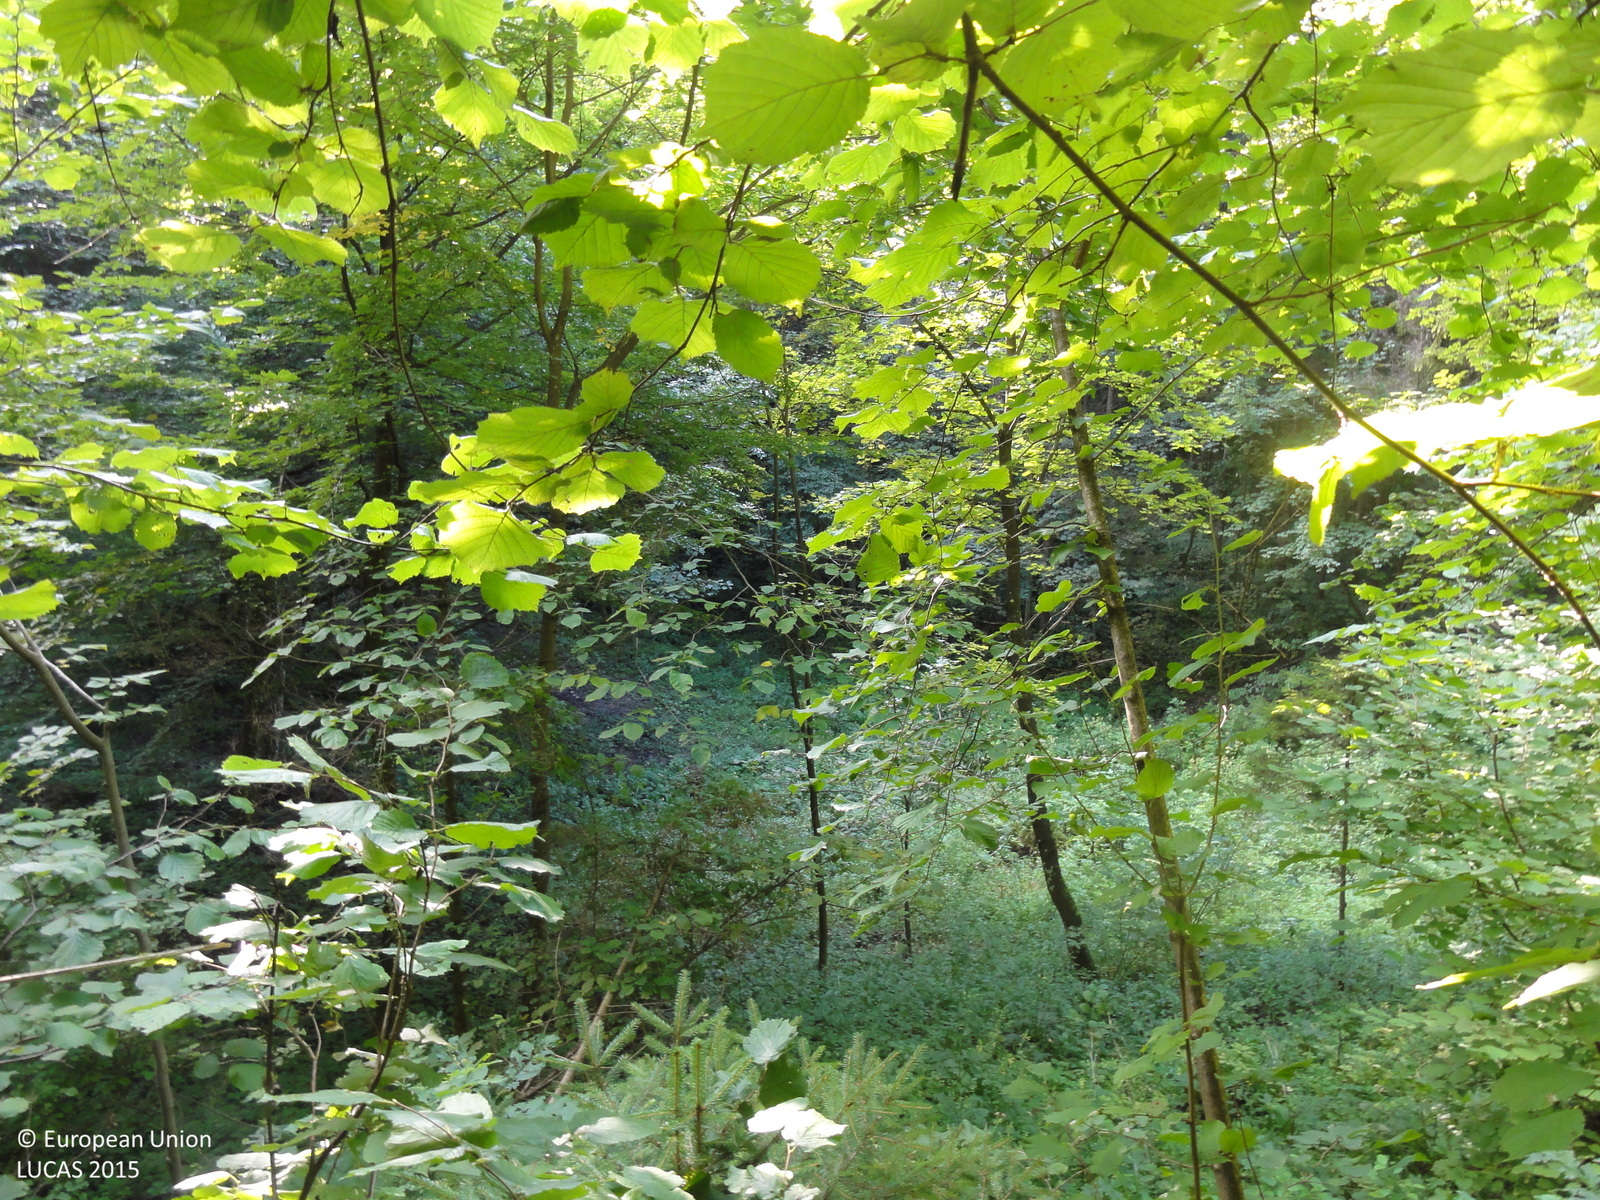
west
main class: Woodland
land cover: Broadleaved woodland
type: beech forest
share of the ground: 50 - 75 %
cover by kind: broadleaved forest trees 65 %, shrubs 20 %, herbaceous plants 10 %, coniferous forest trees 5 %
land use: Forestry
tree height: > 5 m
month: August
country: SI
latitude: 46.1030
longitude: 15.4698
